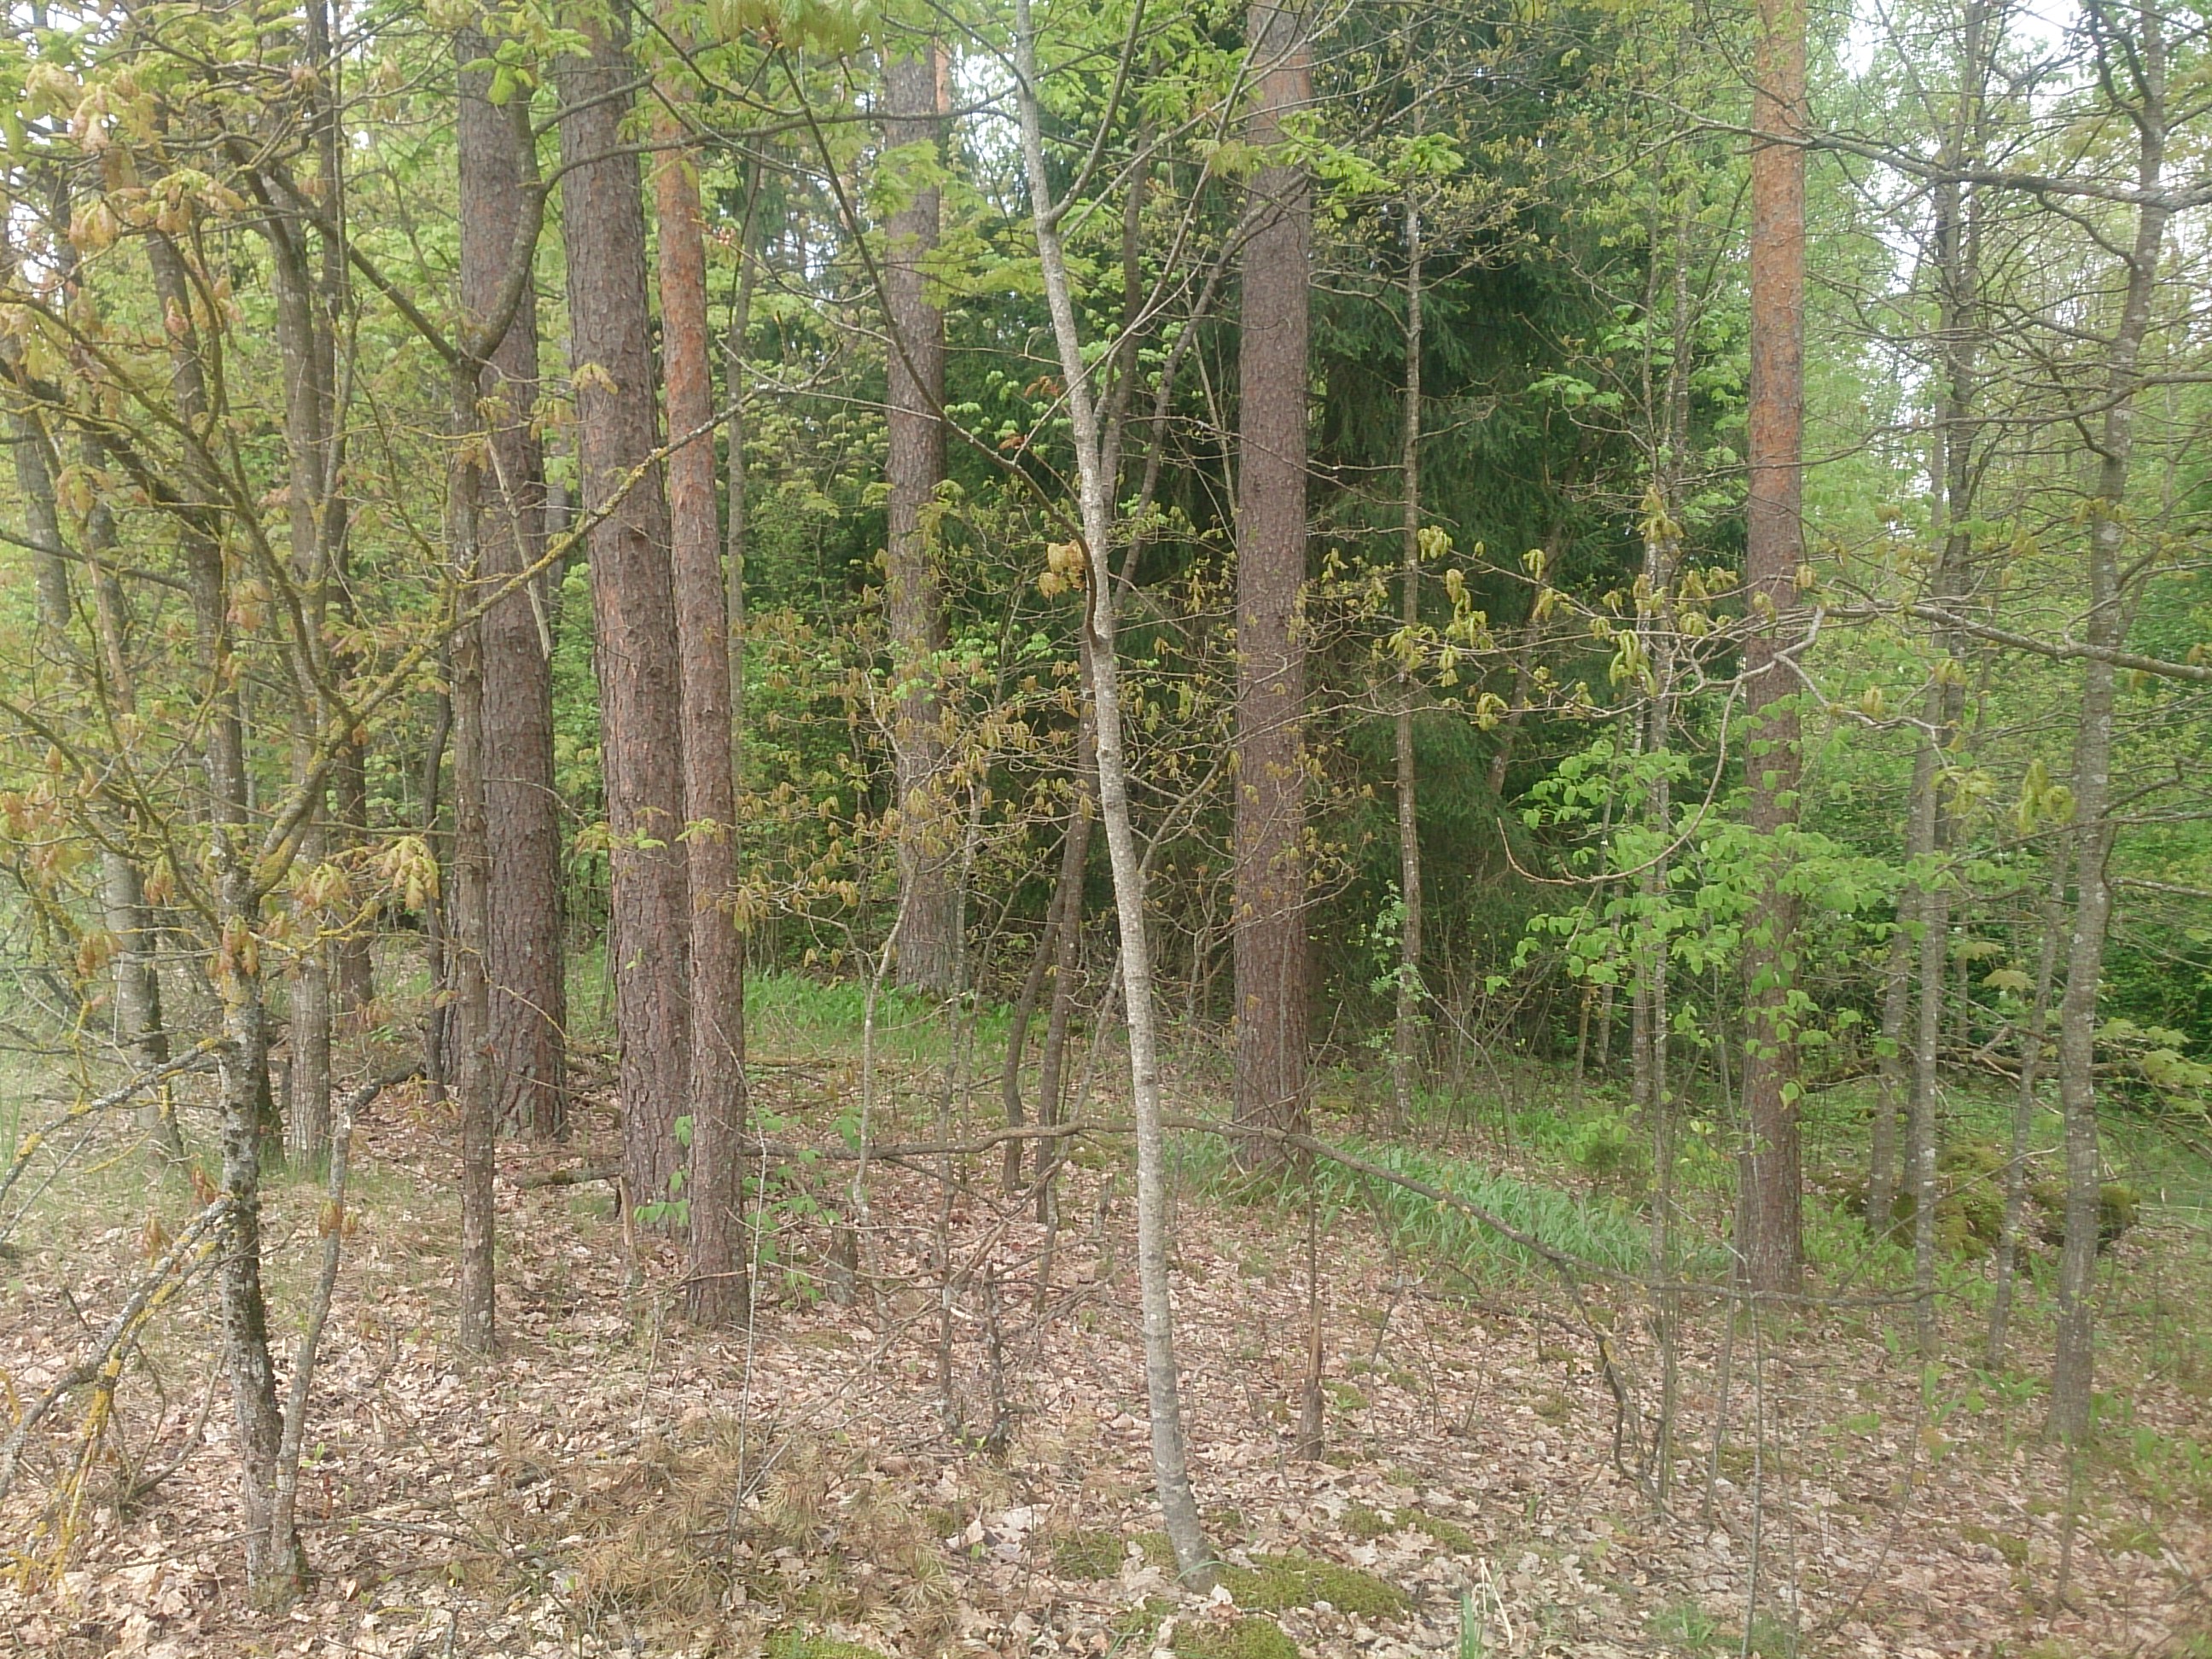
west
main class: Woodland
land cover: Pine dominated mixed woodland
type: hemiboreal forest and nemoral coniferous forest and mixed broadleaved-coniferous forest
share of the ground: > 75 %
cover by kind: coniferous forest trees 60 %, broadleaved forest trees 25 %, herbaceous plants 10 %, lichens and mosses 5 %
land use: Forestry
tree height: > 5 m
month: May
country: LV
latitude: 56.6689
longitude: 24.2371
